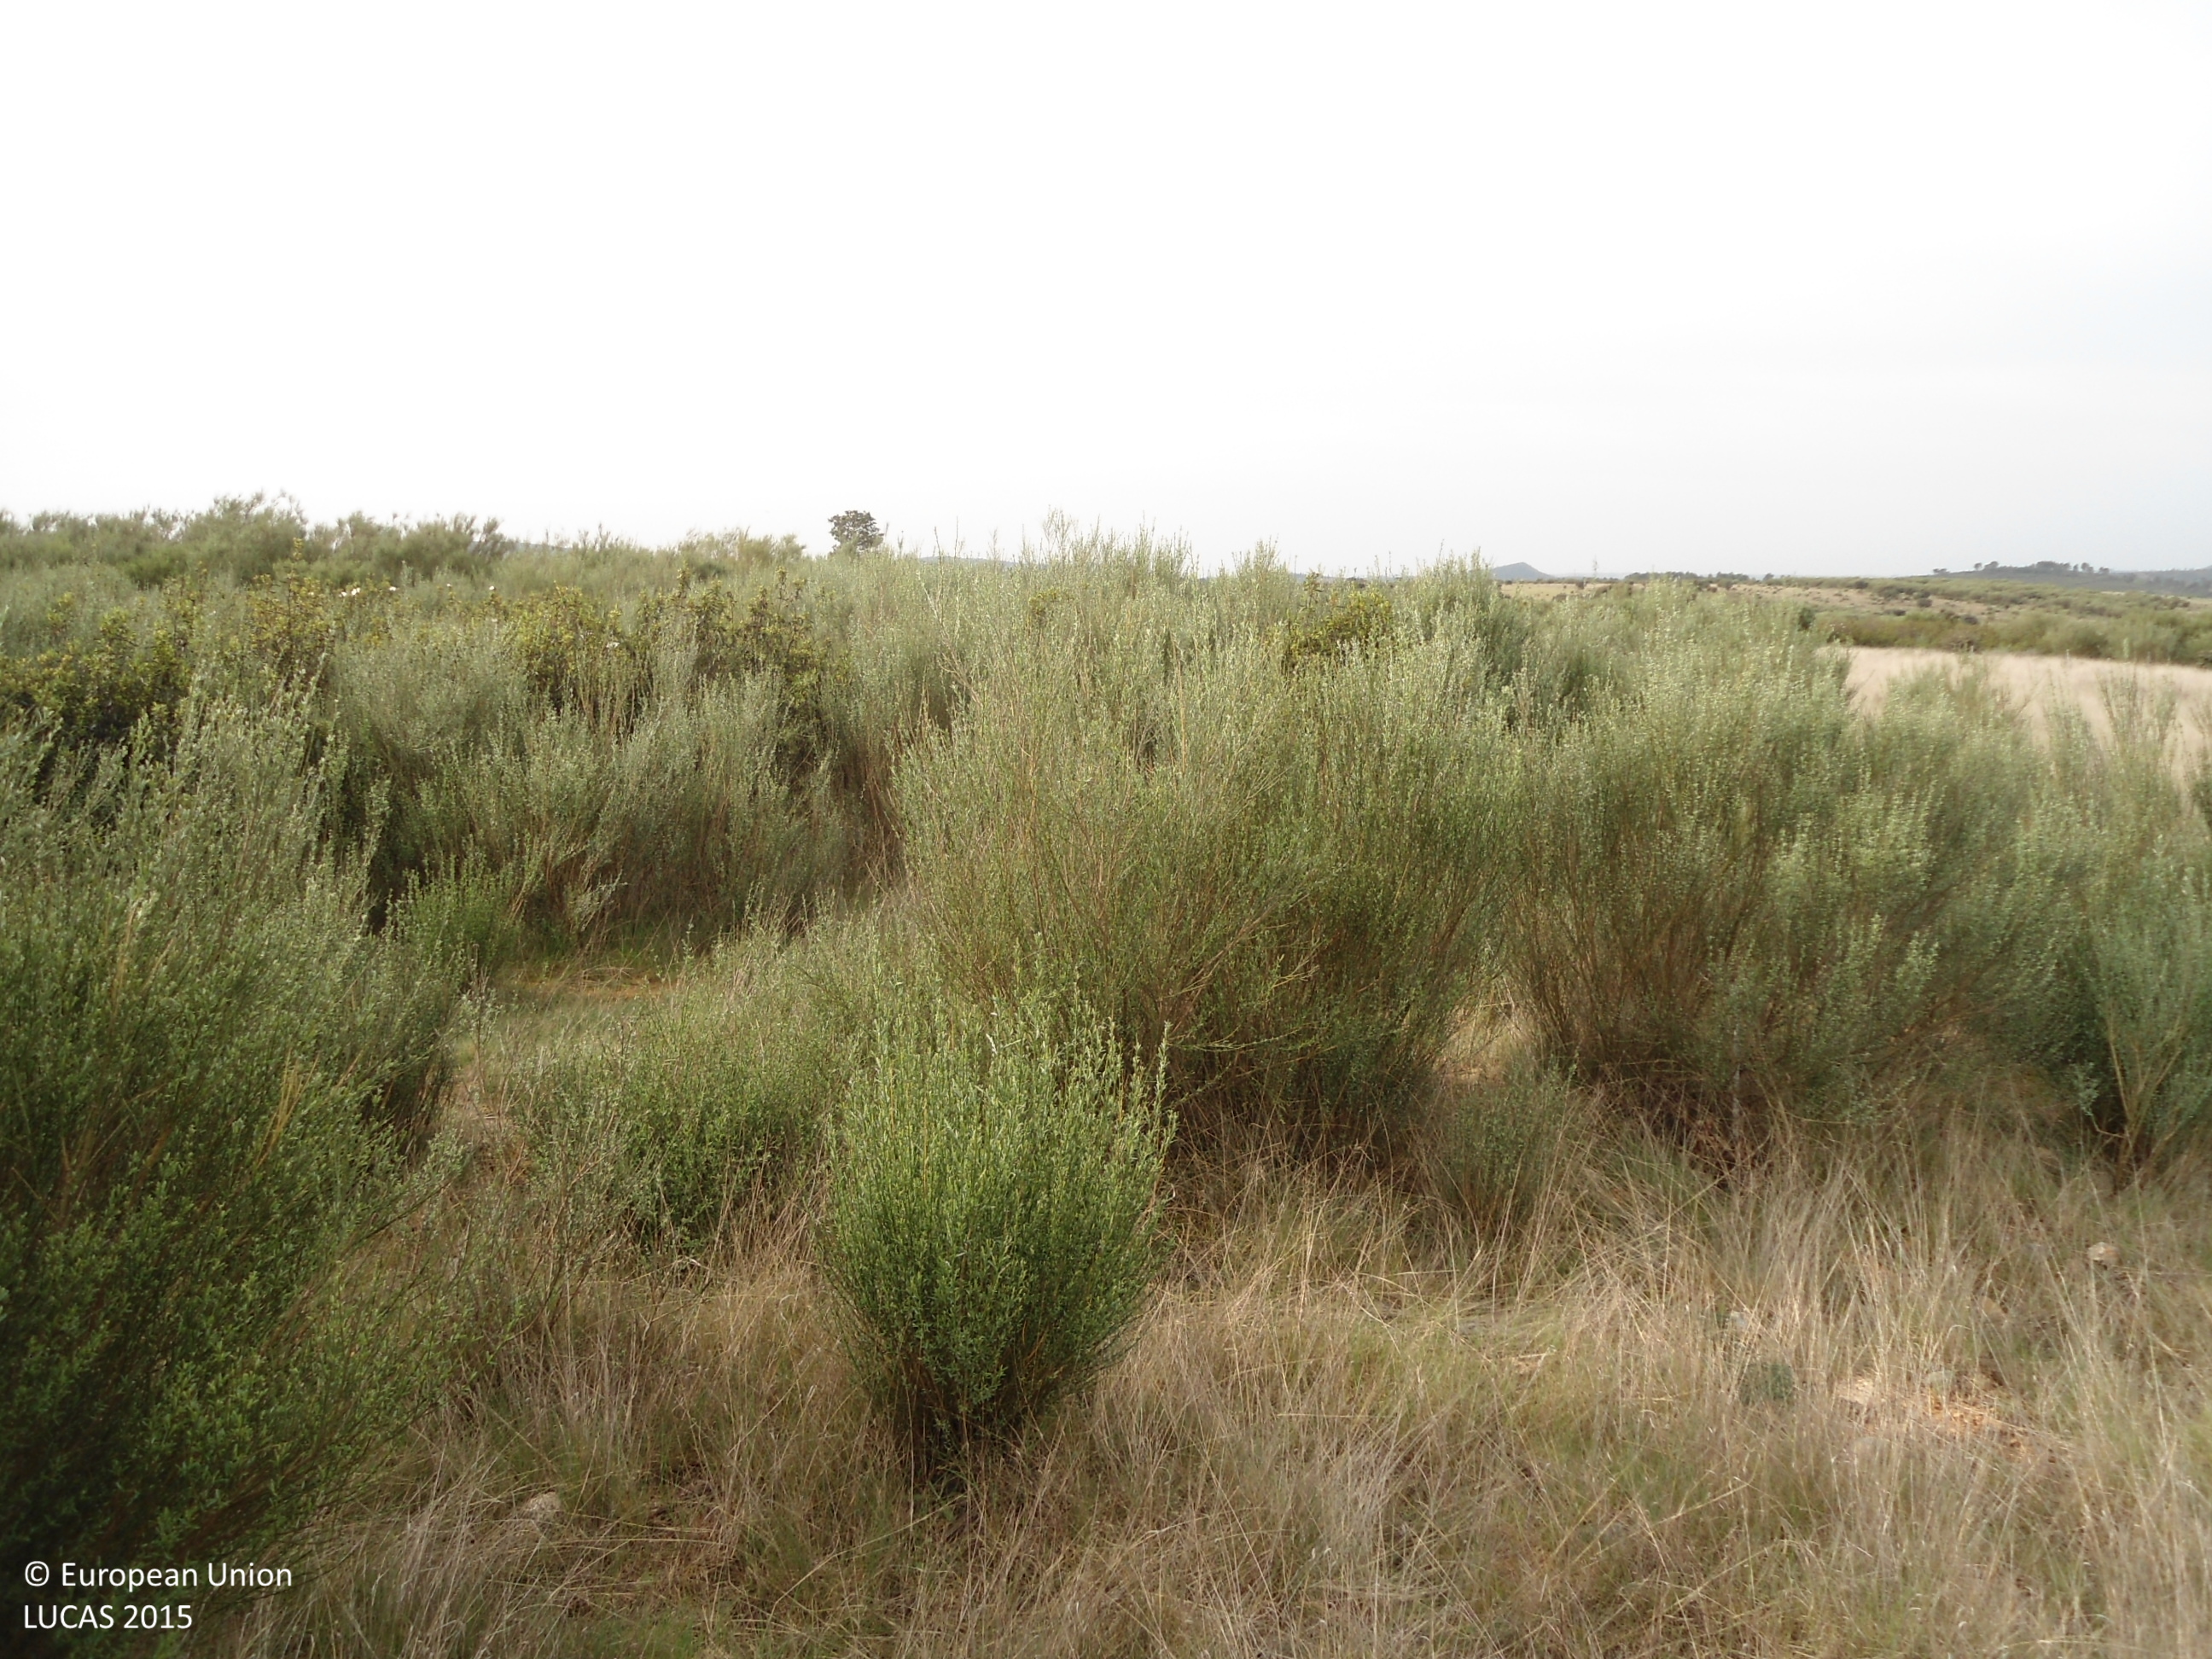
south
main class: Cropland
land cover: Nuts trees
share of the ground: < 10 %
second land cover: Shrubland without tree cover
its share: 50 - 75 %
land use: Abandoned areas
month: April
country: ES
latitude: 41.7462
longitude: -6.5211
